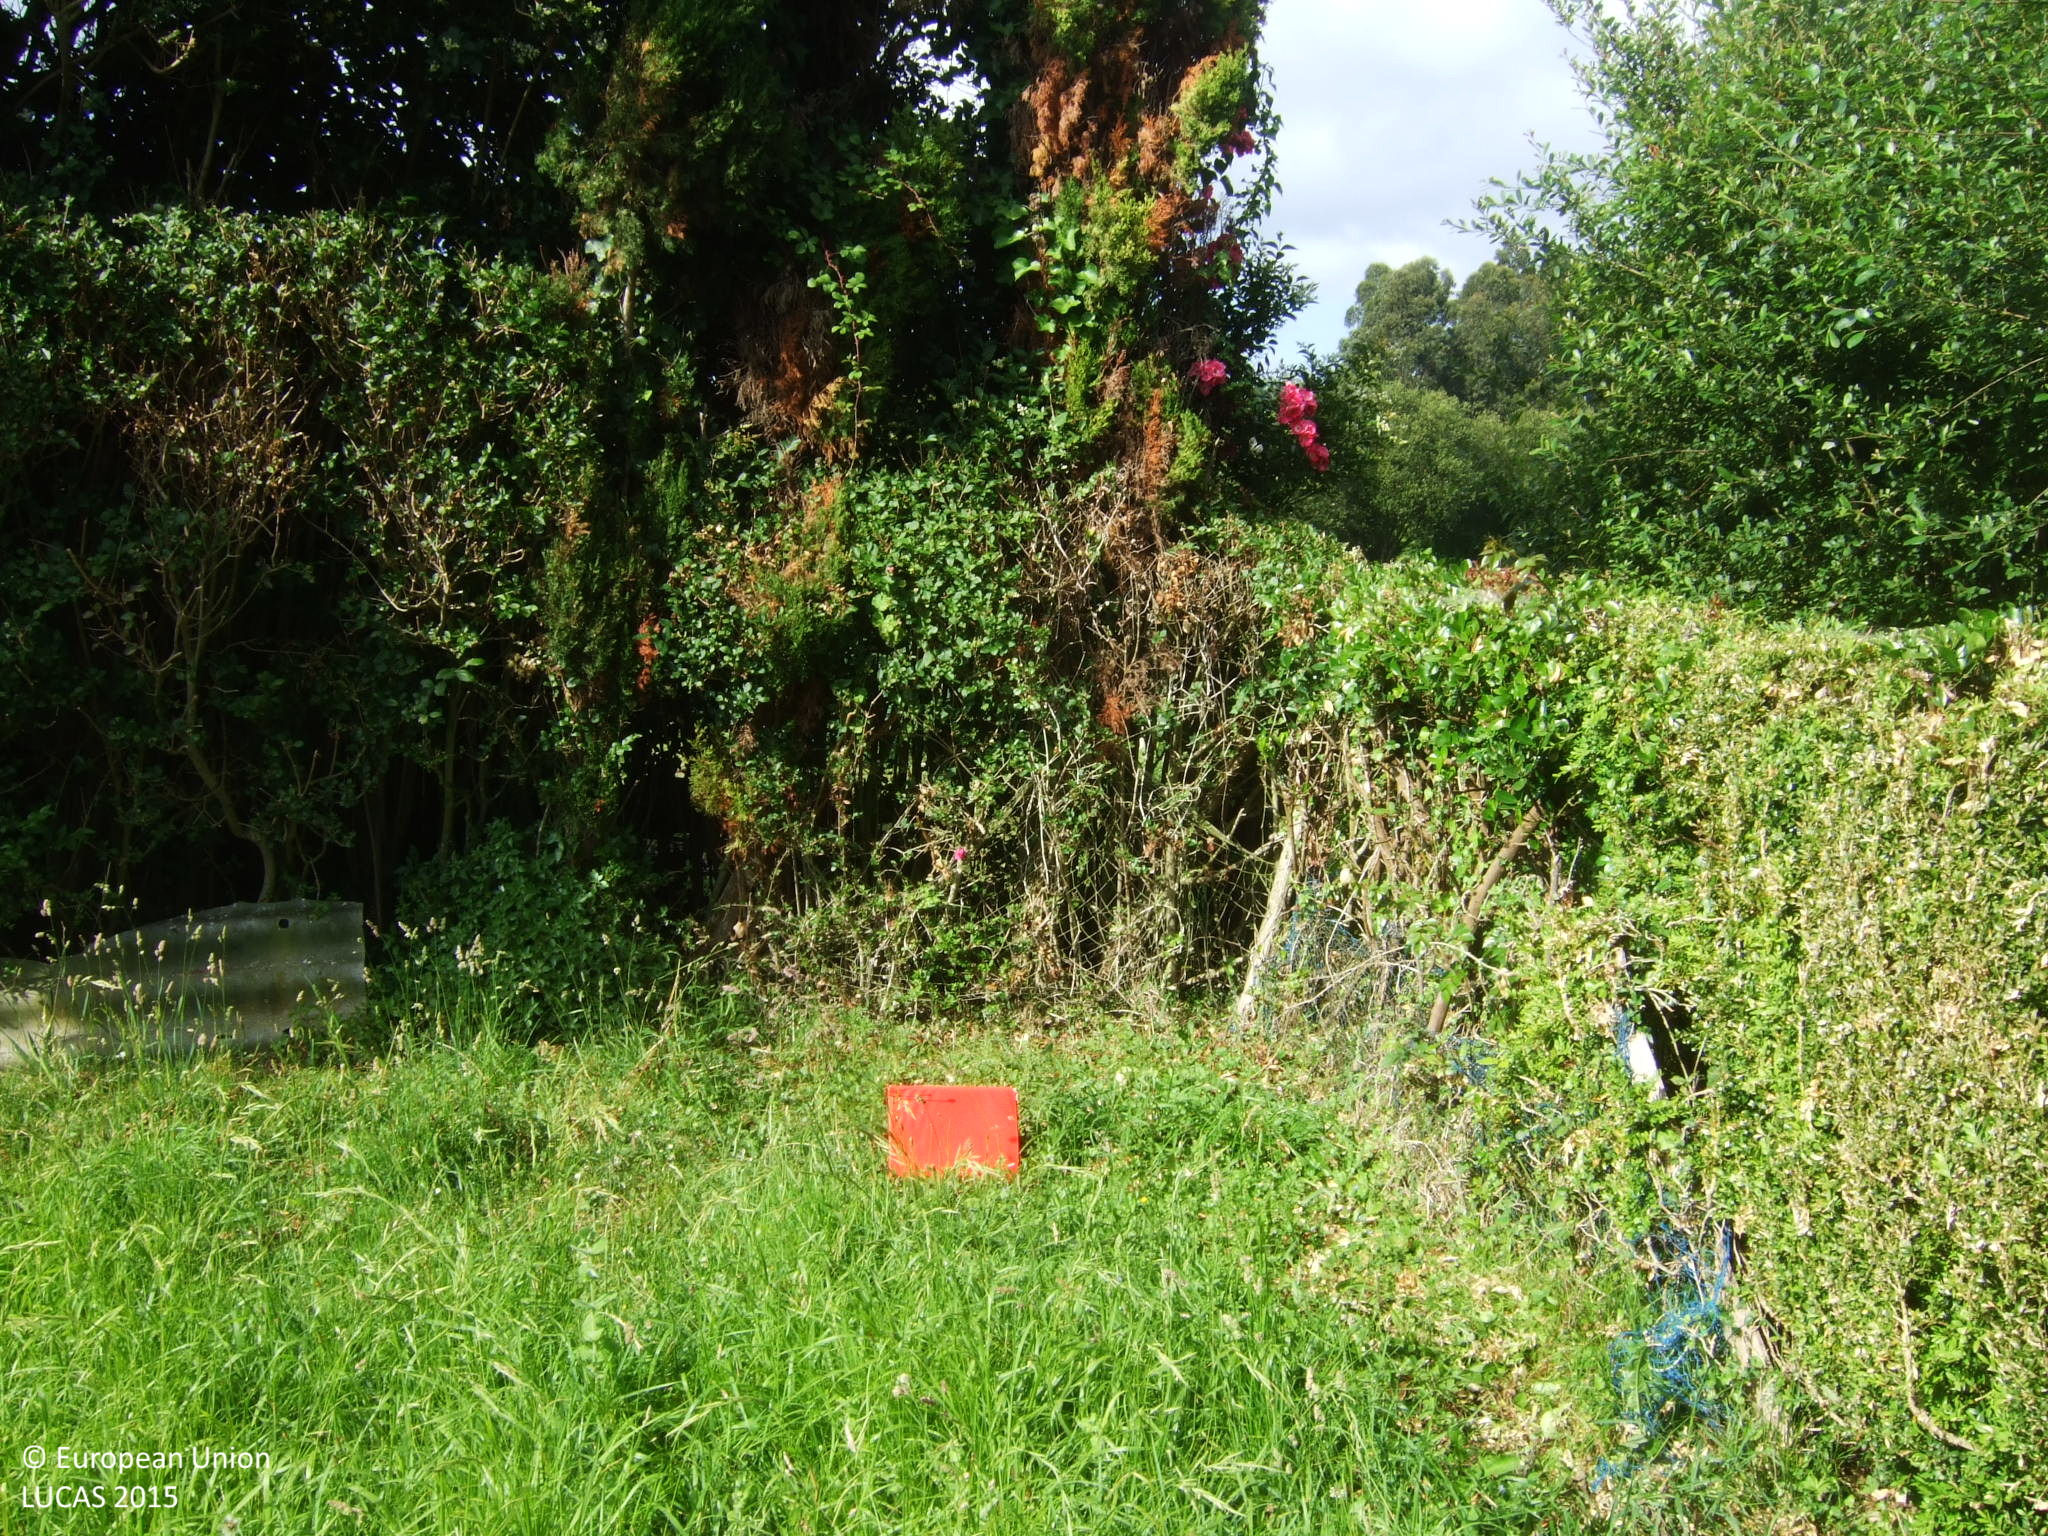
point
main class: Grassland
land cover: Grassland without tree/shrub cover
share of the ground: > 75 %
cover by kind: herbaceous plants 100 %
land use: Agriculture (excluding fallow land and kitchen gardens)
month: June
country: ES
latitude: 43.6945
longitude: -7.6189
